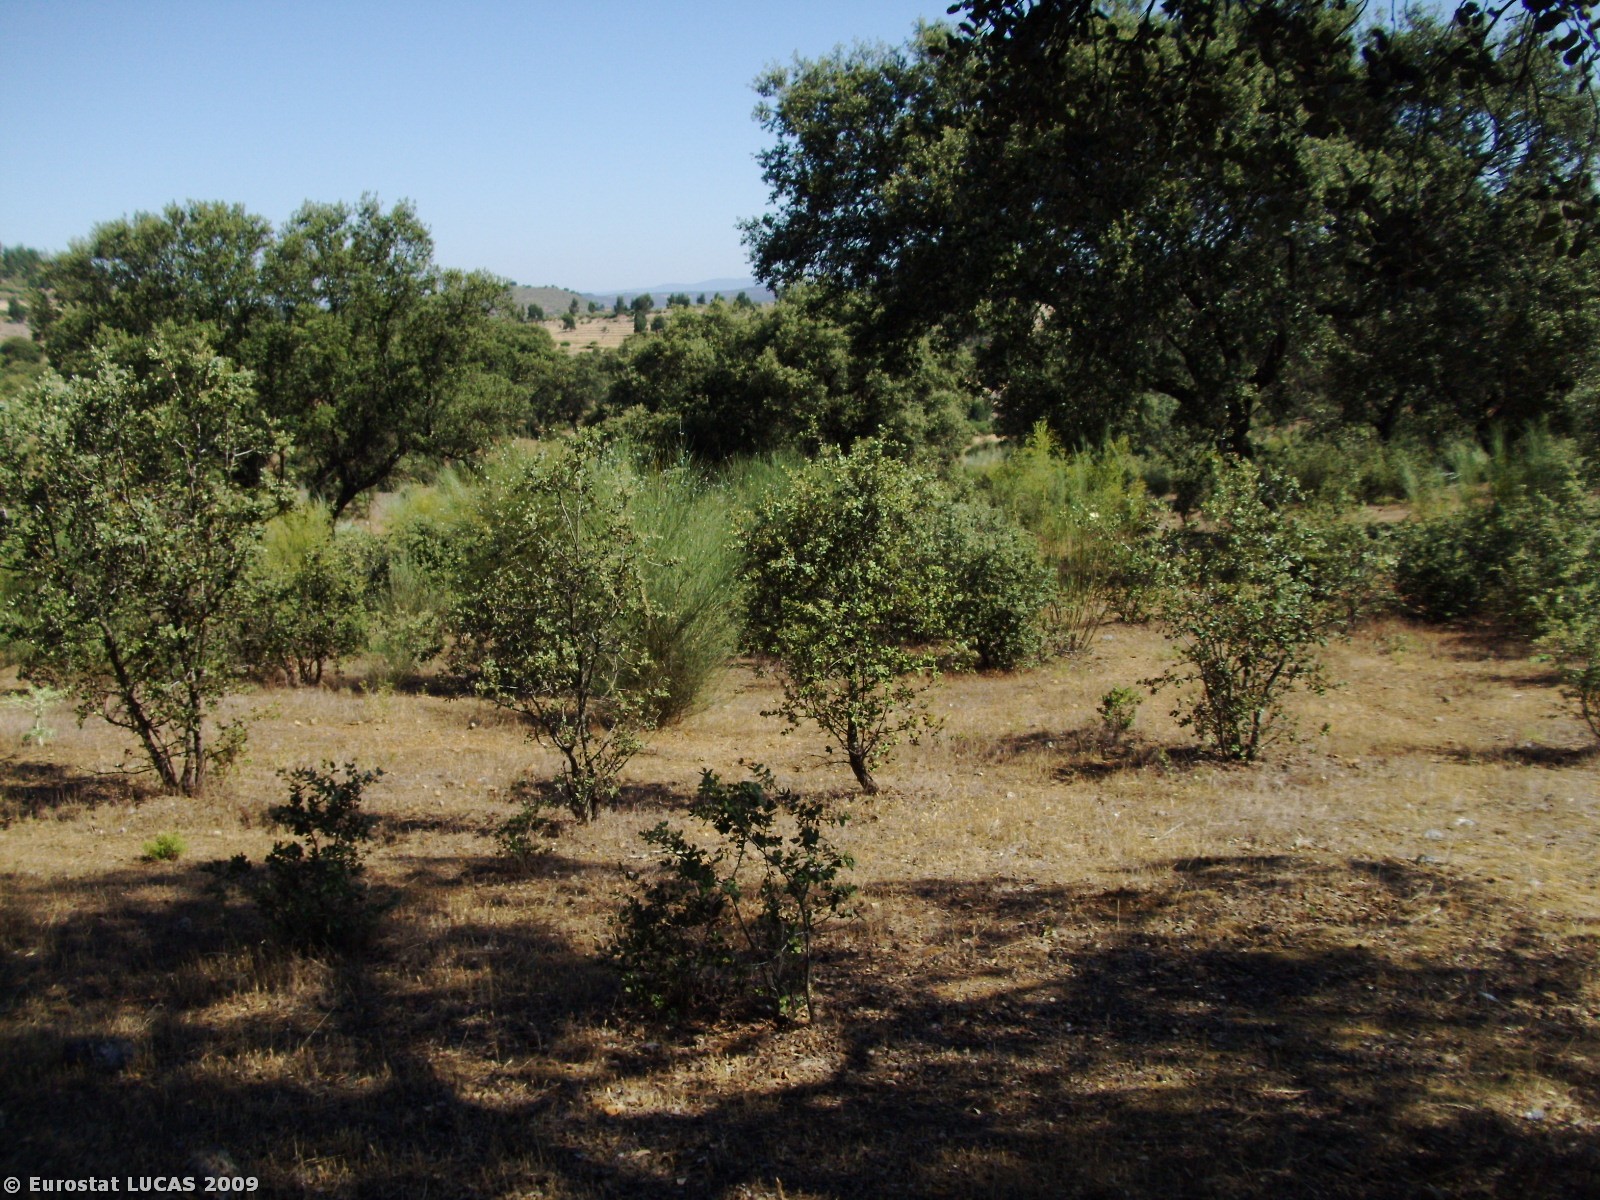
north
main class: Woodland
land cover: Broadleaved woodland
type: broadleaved evergreen forest
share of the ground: 10 - 25 %
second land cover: Spontaneously vegetated surfaces
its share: 50 - 75 %
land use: Forestry
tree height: > 5 m
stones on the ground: 25 - 50 %
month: June
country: PT
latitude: 39.9185
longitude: -7.1862
